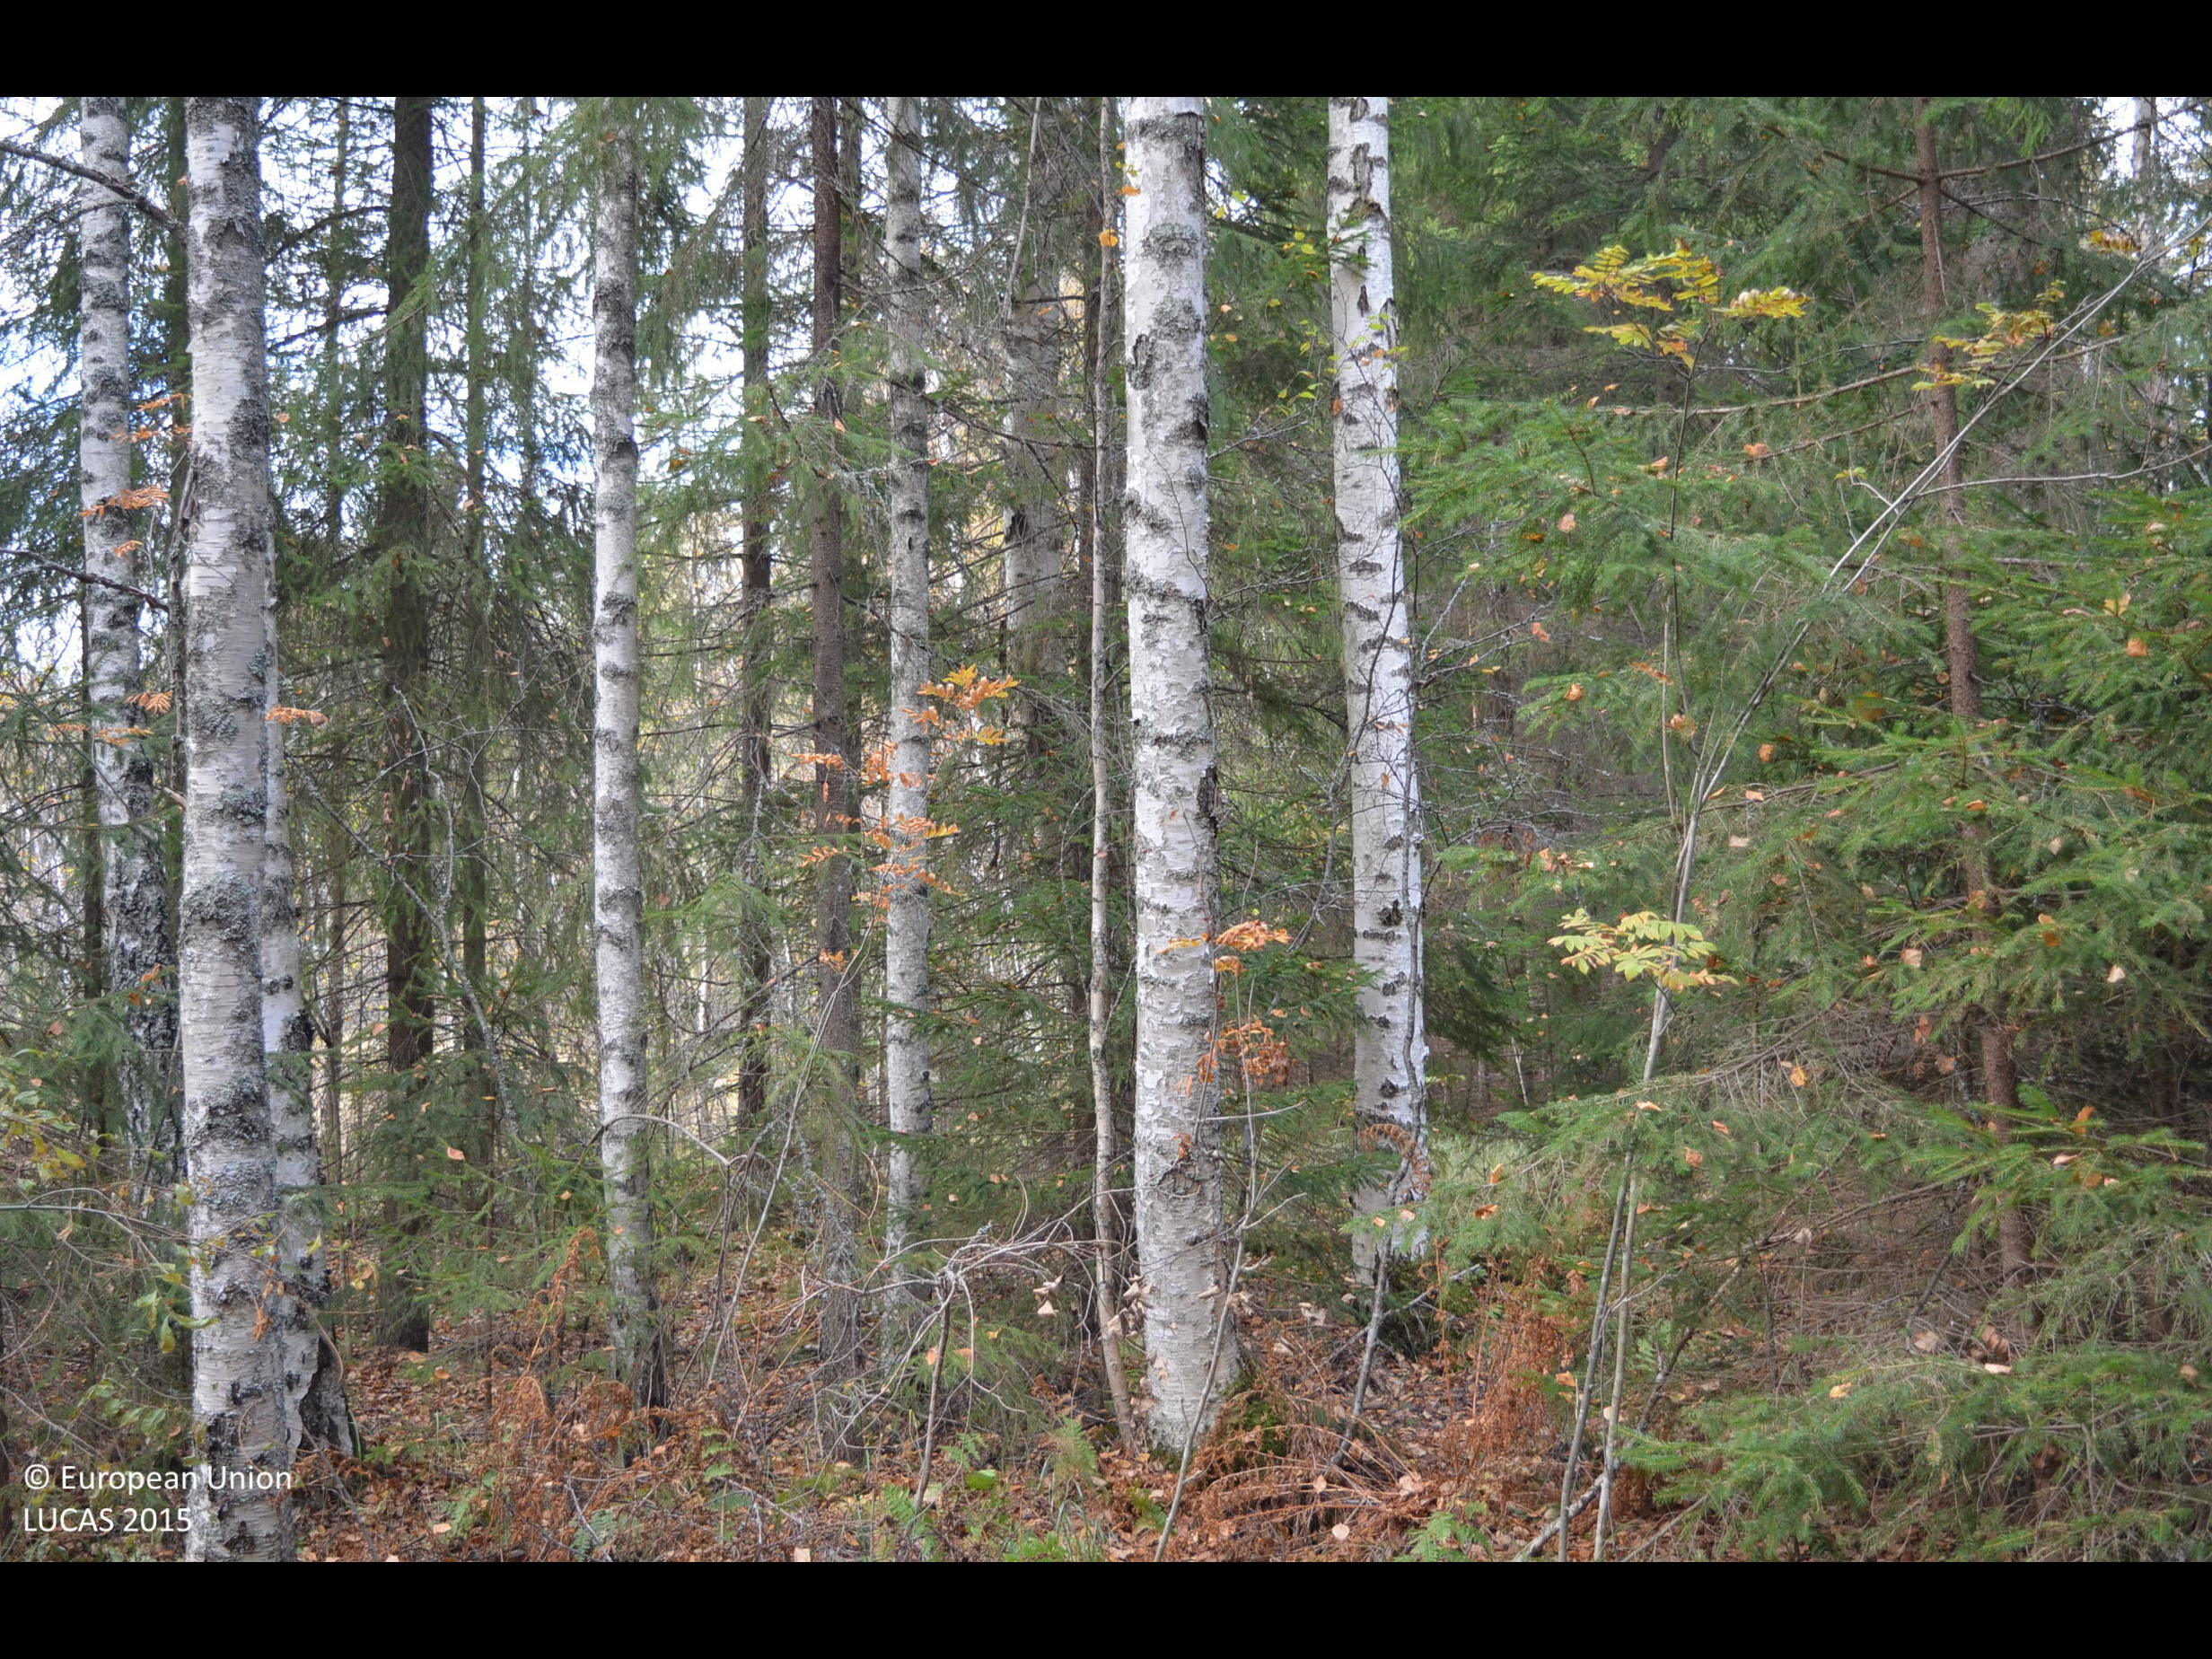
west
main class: Woodland
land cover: Spruce dominated mixed woodland
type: boreal forest
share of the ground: 50 - 75 %
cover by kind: coniferous forest trees 35 %, broadleaved forest trees 35 %, herbaceous plants 25 %, shrubs 5 %
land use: Forestry
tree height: > 5 m
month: October
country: FI
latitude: 61.6914
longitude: 23.8647
